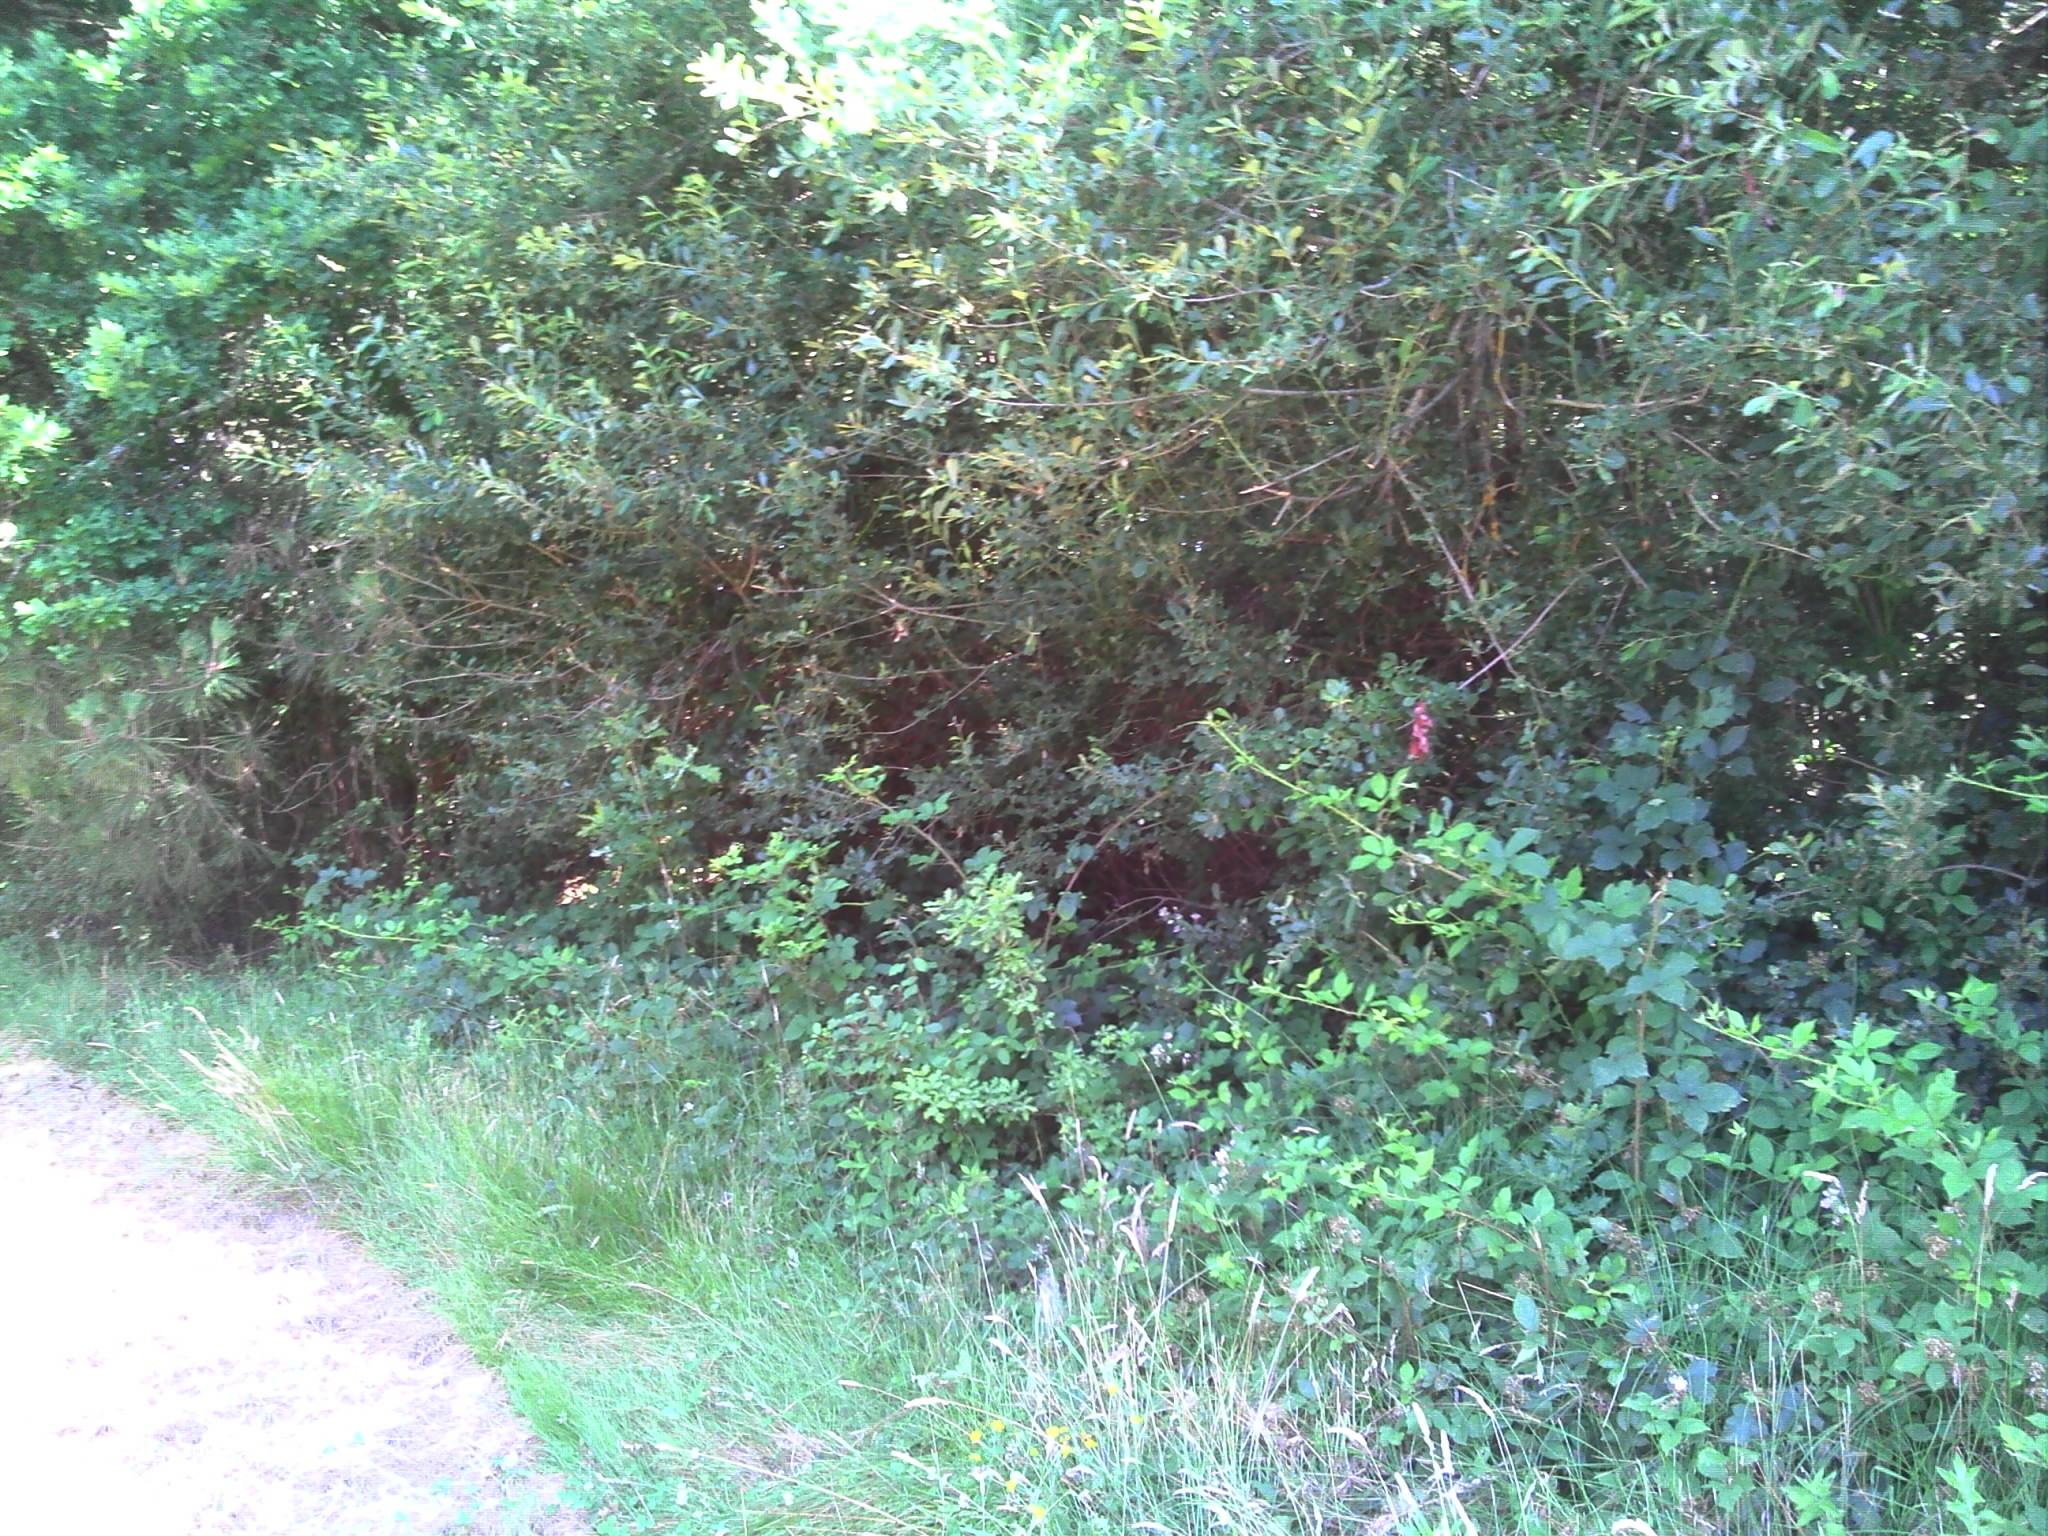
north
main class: Grassland
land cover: Grassland without tree/shrub cover
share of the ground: > 75 %
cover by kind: herbaceous plants 100 %
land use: Semi-natural and natural areas not in use
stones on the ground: < 10 %
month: June
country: FR
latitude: 47.1518
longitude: -1.9564
